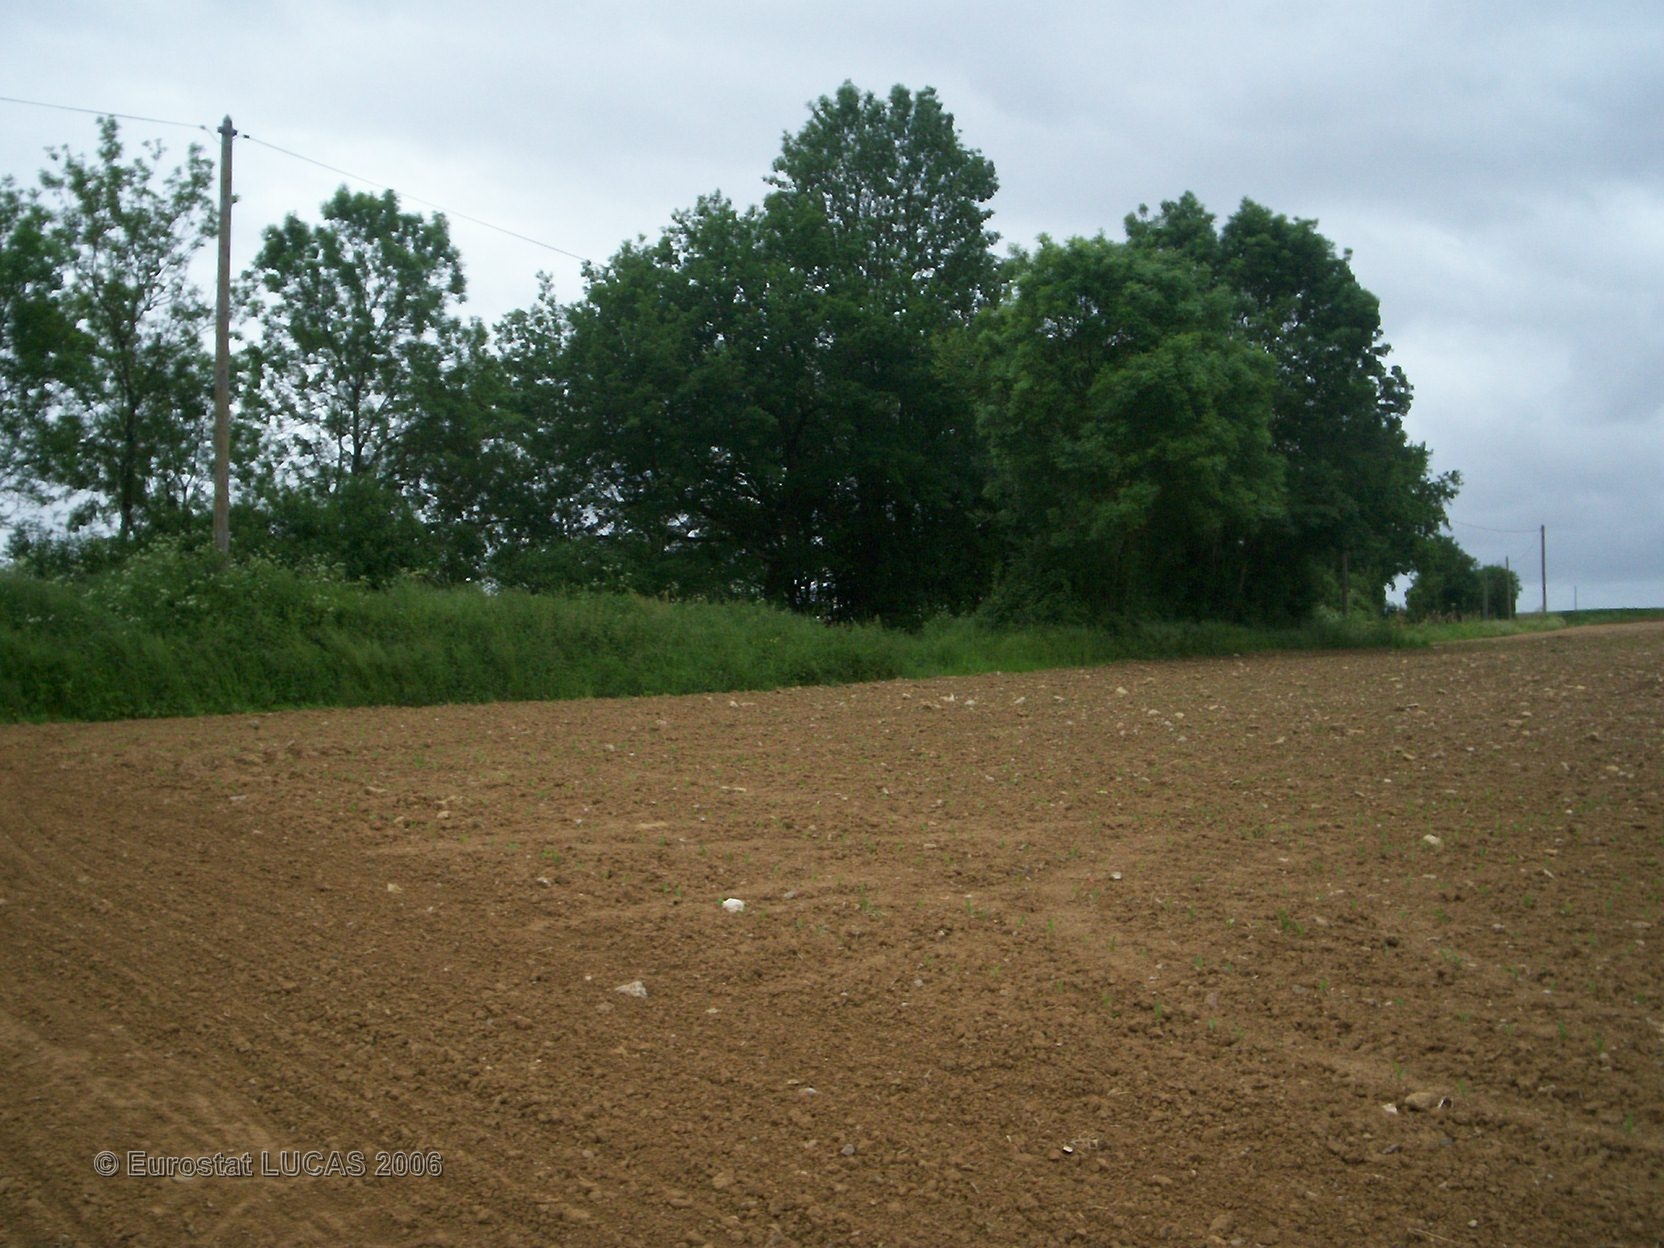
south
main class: Grassland
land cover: Grassland without tree/shrub cover
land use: Agriculture (excluding fallow land and kitchen gardens)
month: May
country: FR
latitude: 46.5077
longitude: -0.8337
